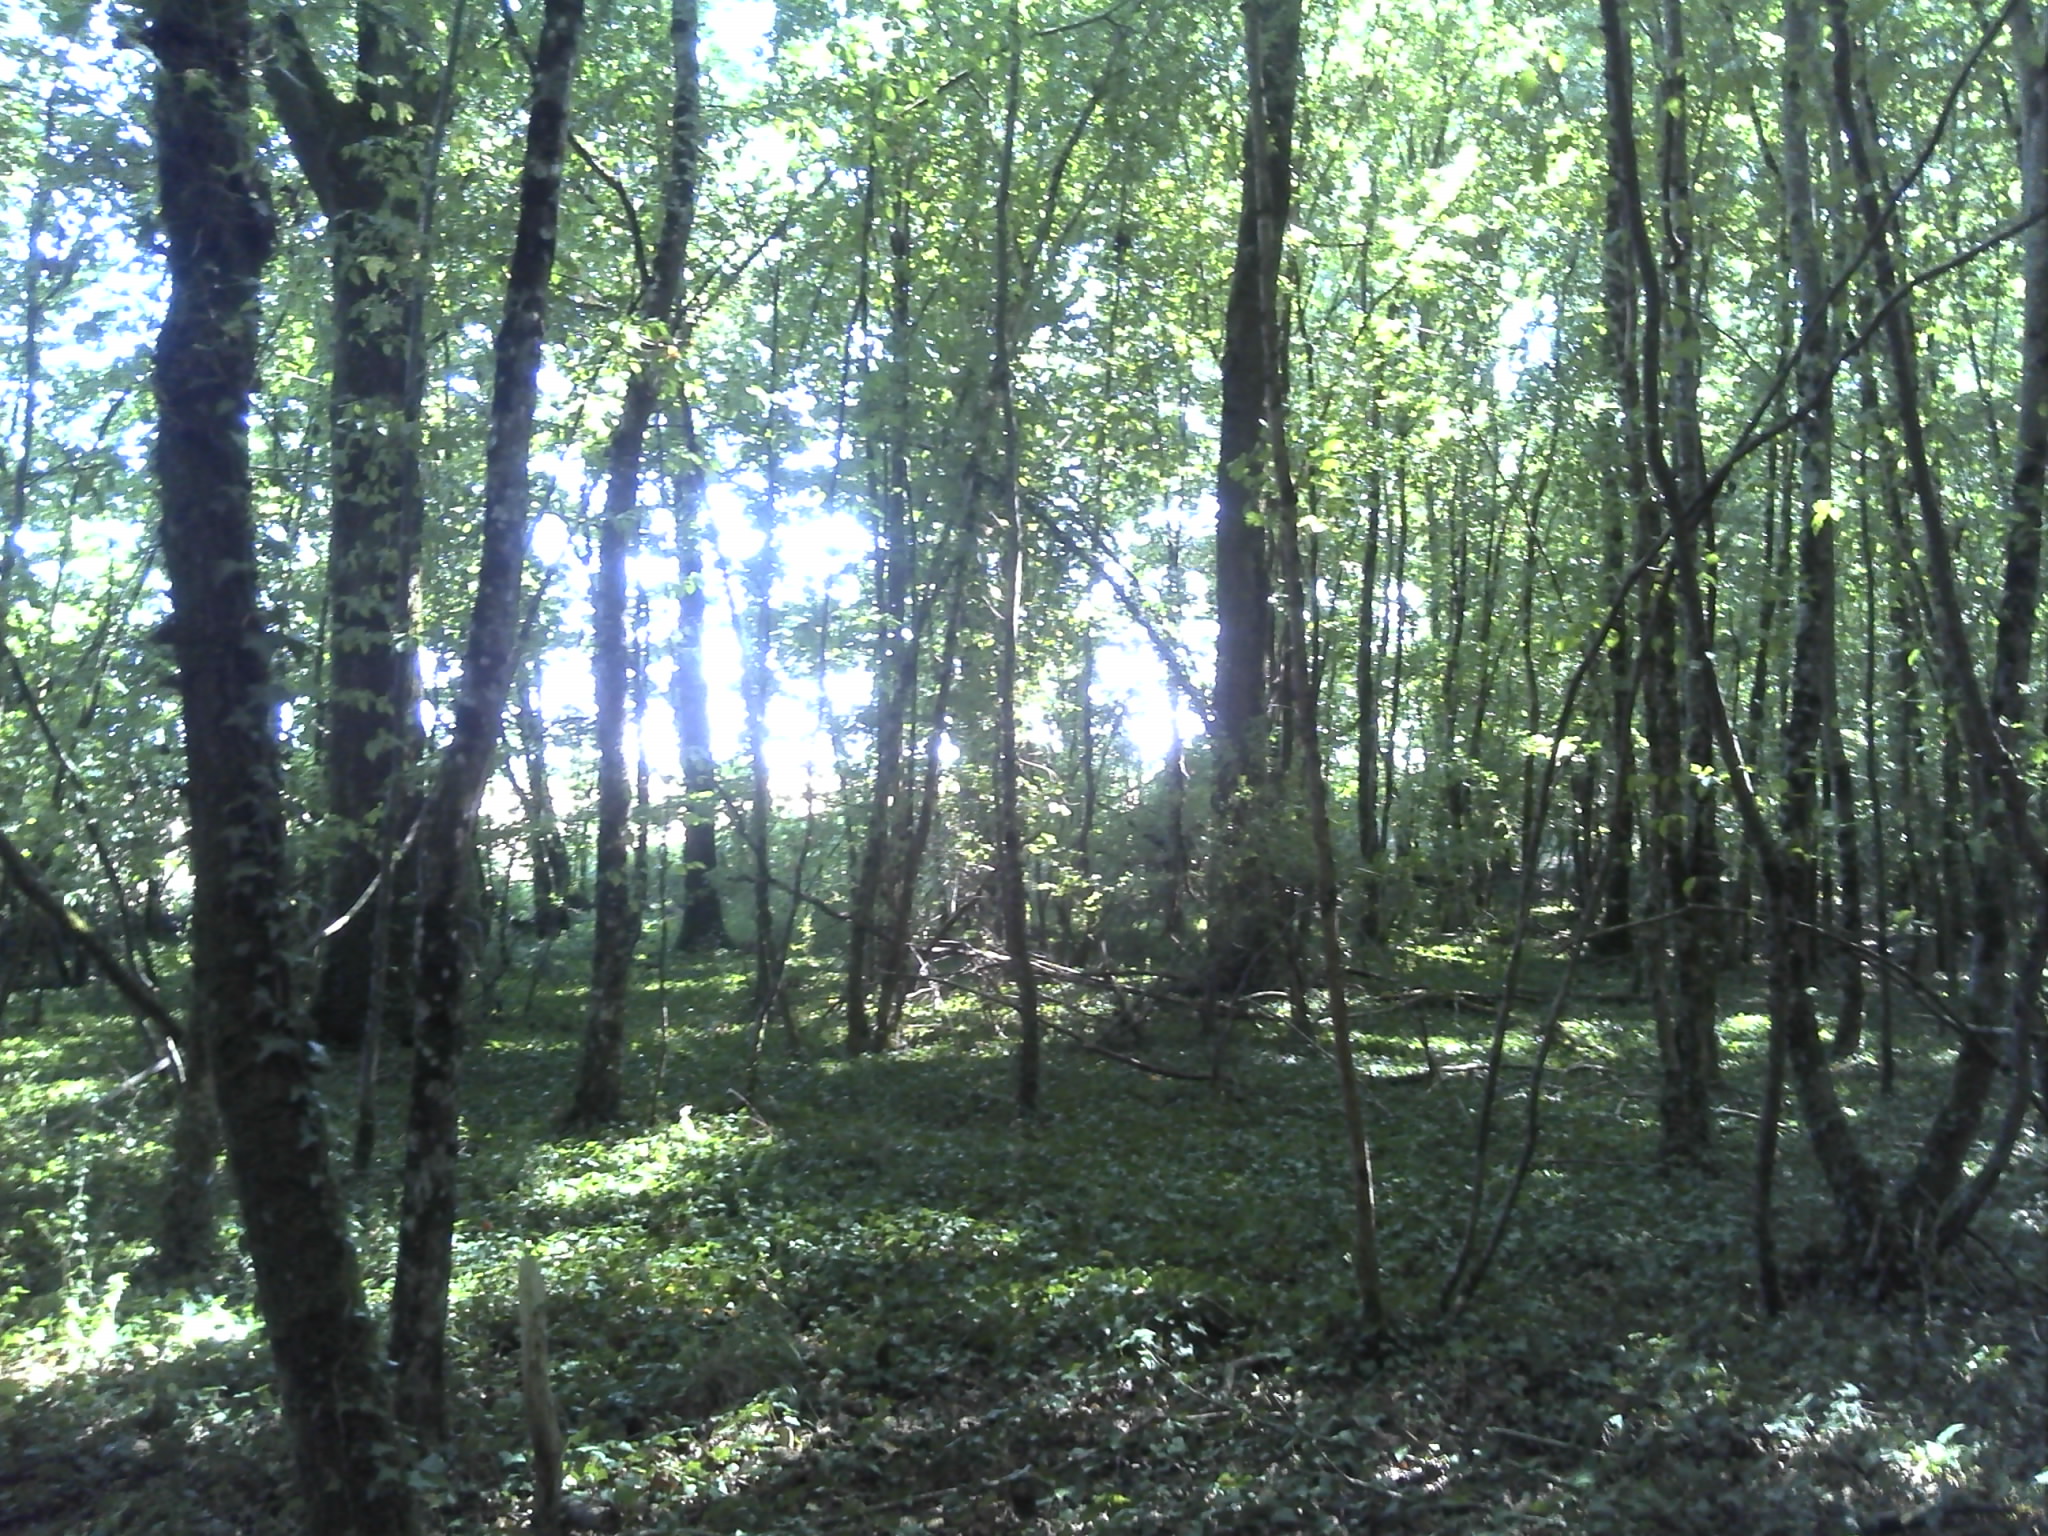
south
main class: Woodland
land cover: Broadleaved woodland
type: mesophytic deciduous forest
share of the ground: > 75 %
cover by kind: broadleaved forest trees 70 %, herbaceous plants 30 %
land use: Forestry
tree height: > 5 m
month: August
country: FR
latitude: 46.8675
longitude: 1.5533
